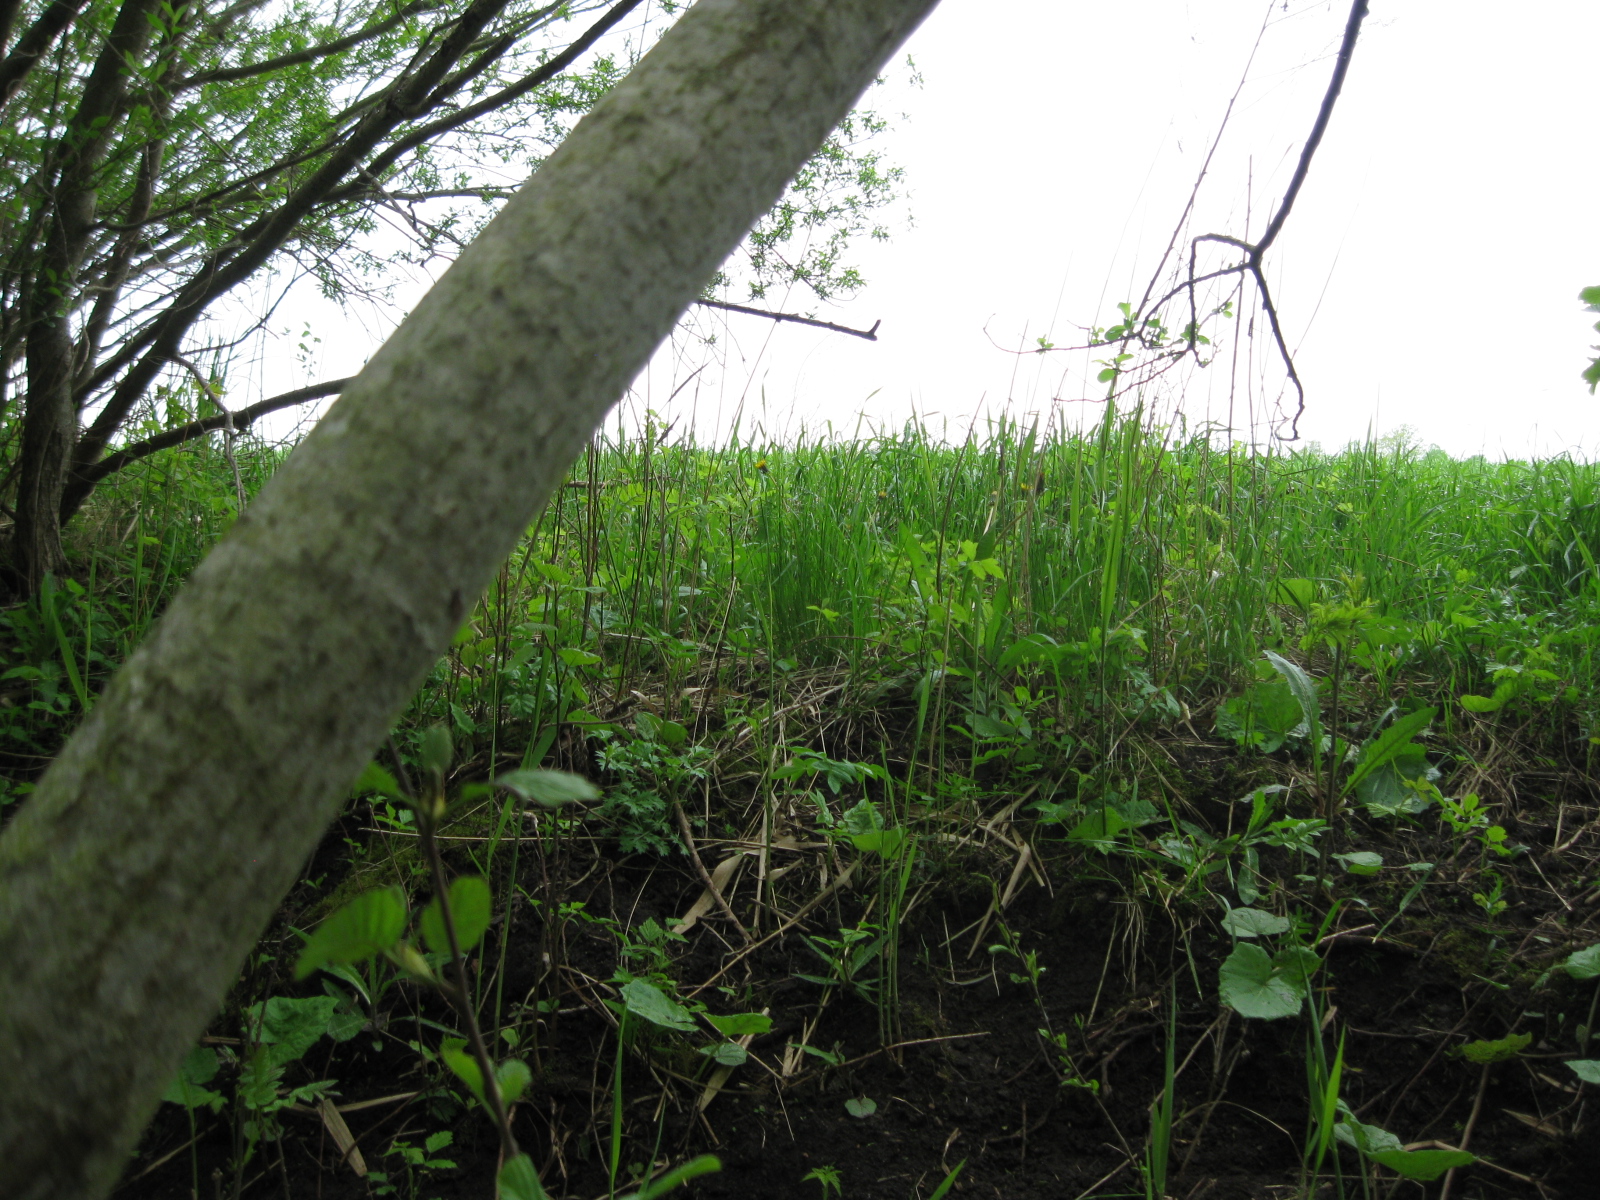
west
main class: Woodland
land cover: Broadleaved woodland
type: non-riverine alder, birch or aspen forest
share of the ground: > 75 %
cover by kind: broadleaved forest trees 85 %, shrubs 5 %, herbaceous plants 5 %, unconsolidated bare surface 5 %
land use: Forestry
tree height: > 5 m
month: May
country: LT
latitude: 56.2012
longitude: 23.8322
